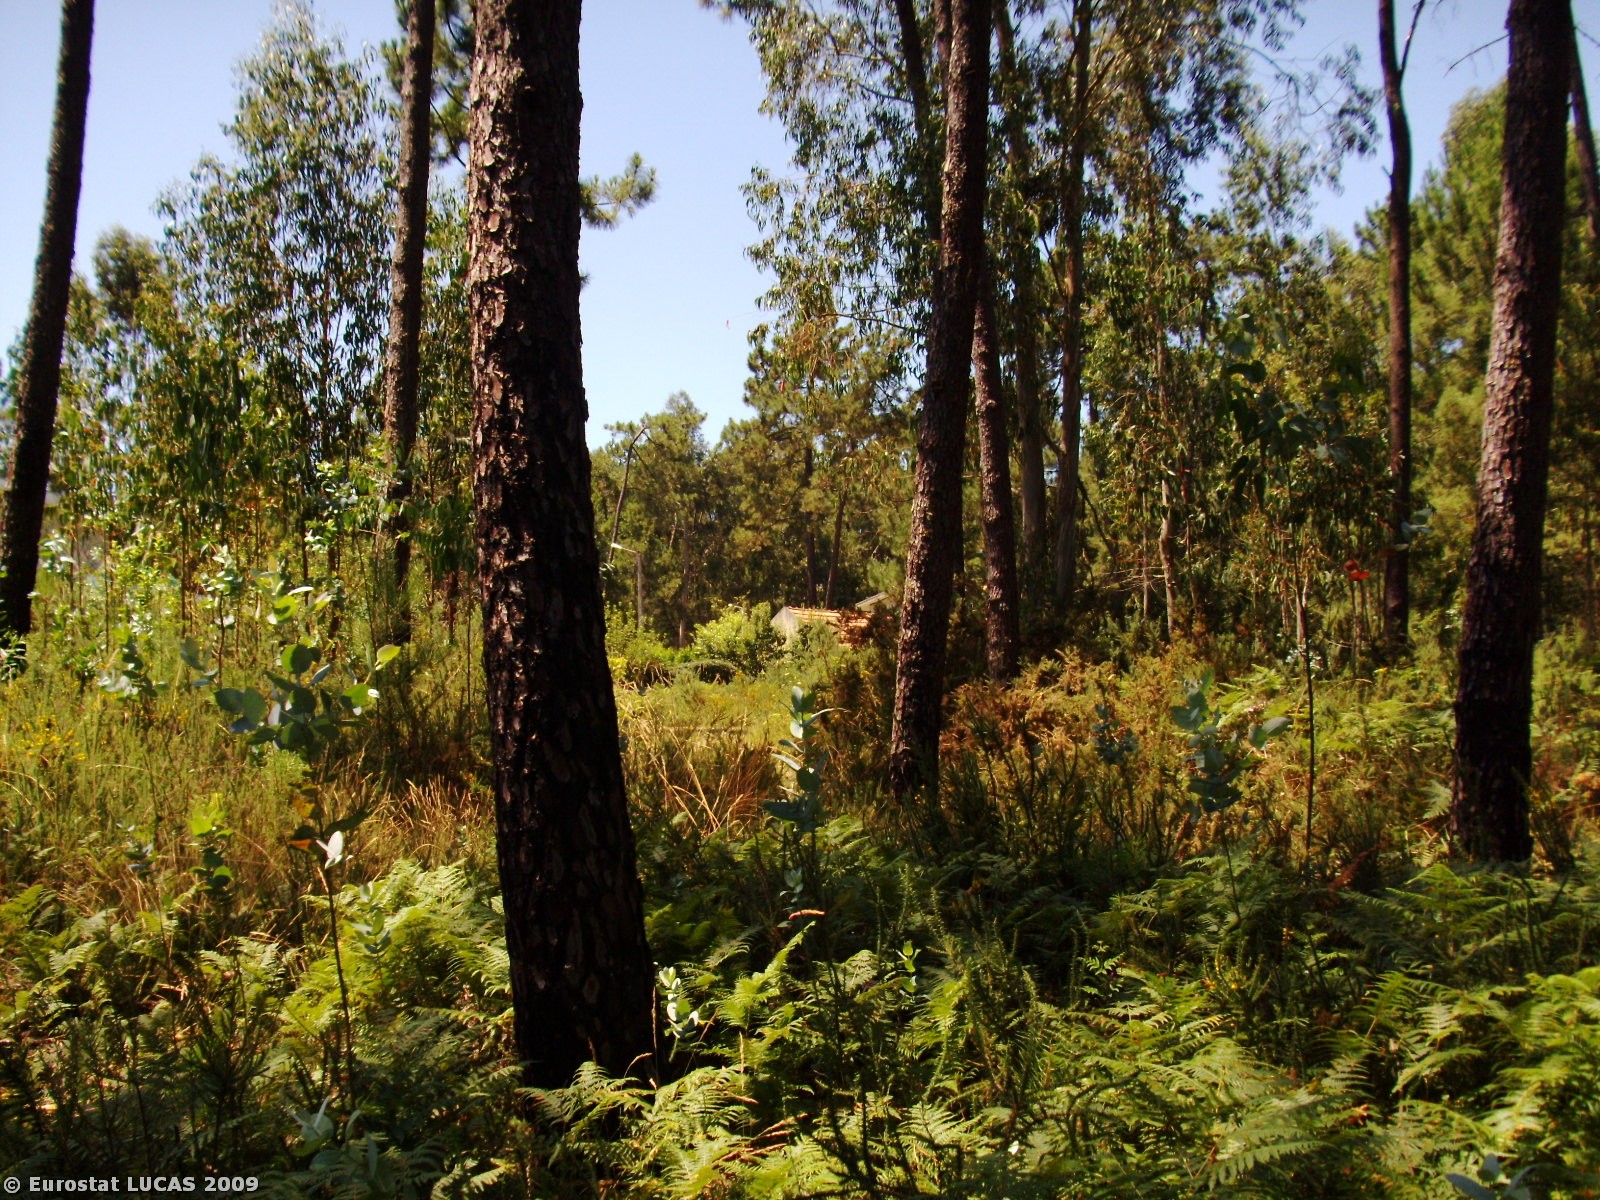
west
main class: Woodland
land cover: Mixed woodland
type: hemiboreal forest and nemoral coniferous forest and mixed broadleaved-coniferous forest
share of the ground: > 75 %
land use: Forestry
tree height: > 5 m
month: July
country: PT
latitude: 41.6183
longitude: -8.7798
